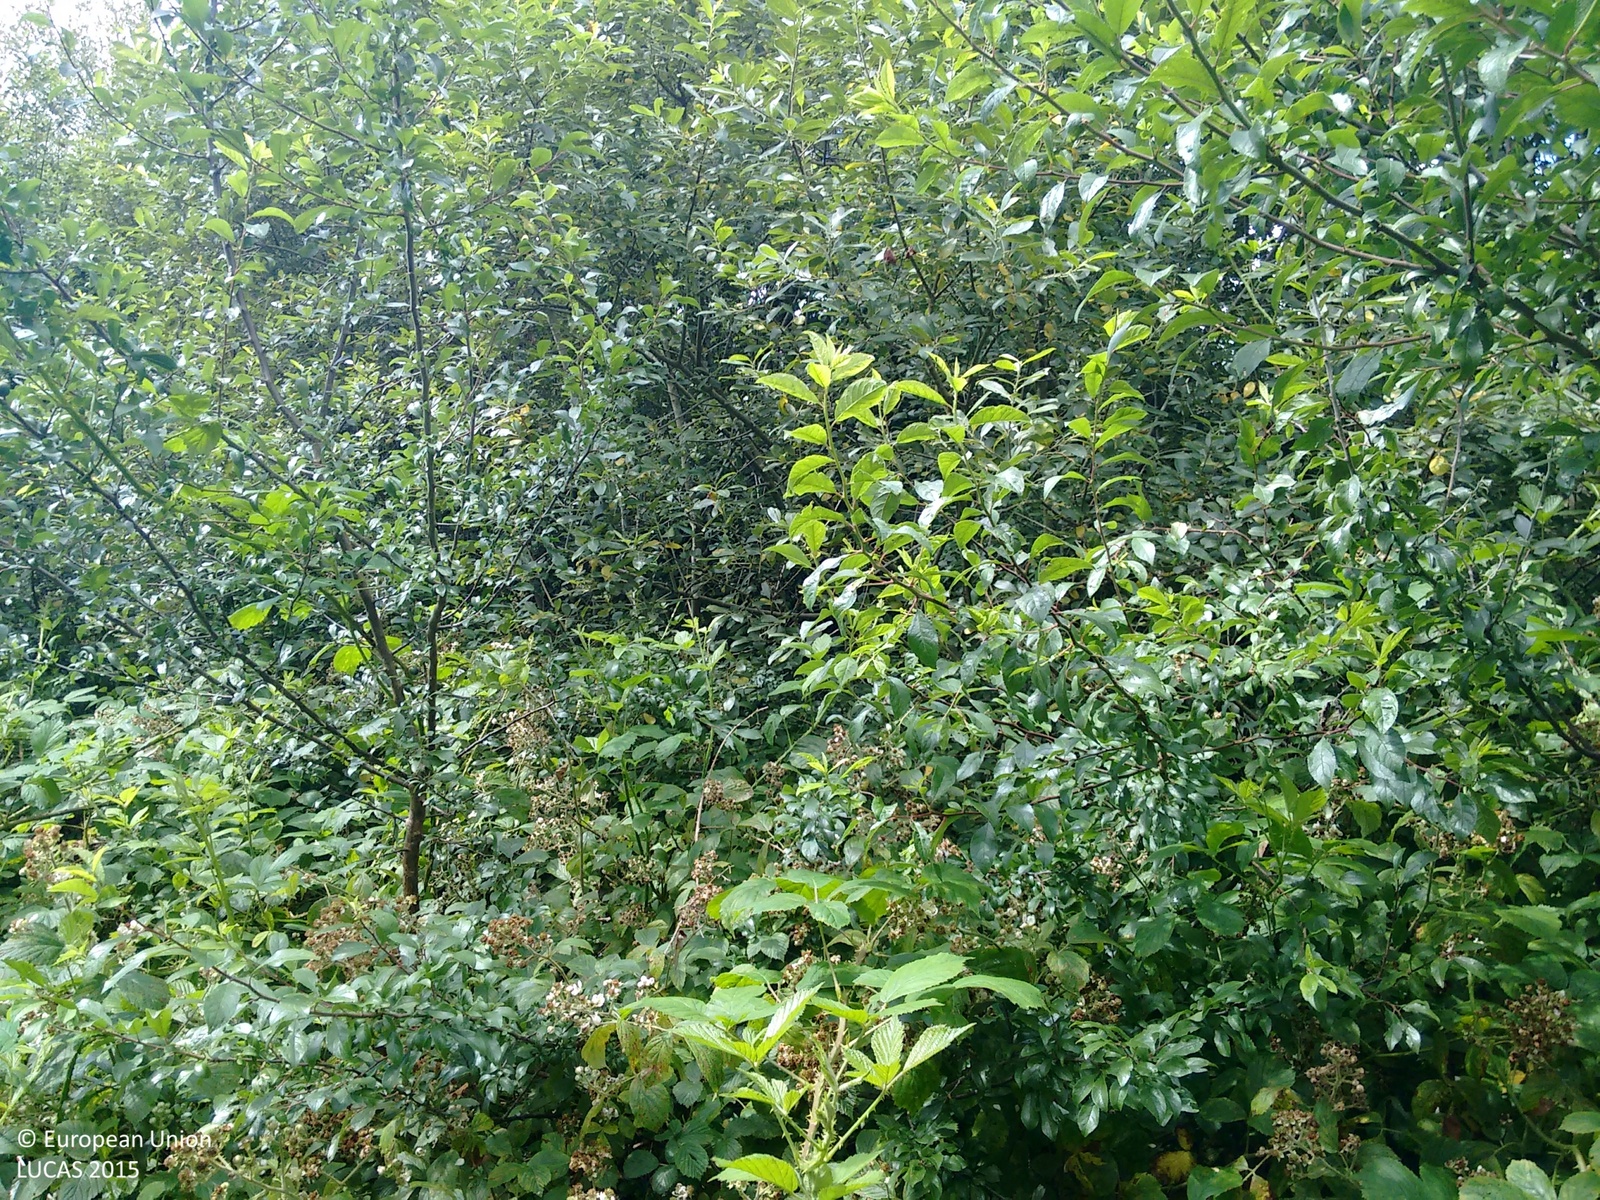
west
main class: Woodland
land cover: Broadleaved woodland
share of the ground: > 75 %
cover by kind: broadleaved forest trees 85 %, shrubs 15 %
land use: Abandoned areas
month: August
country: IE
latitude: 51.7376
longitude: -9.3867
